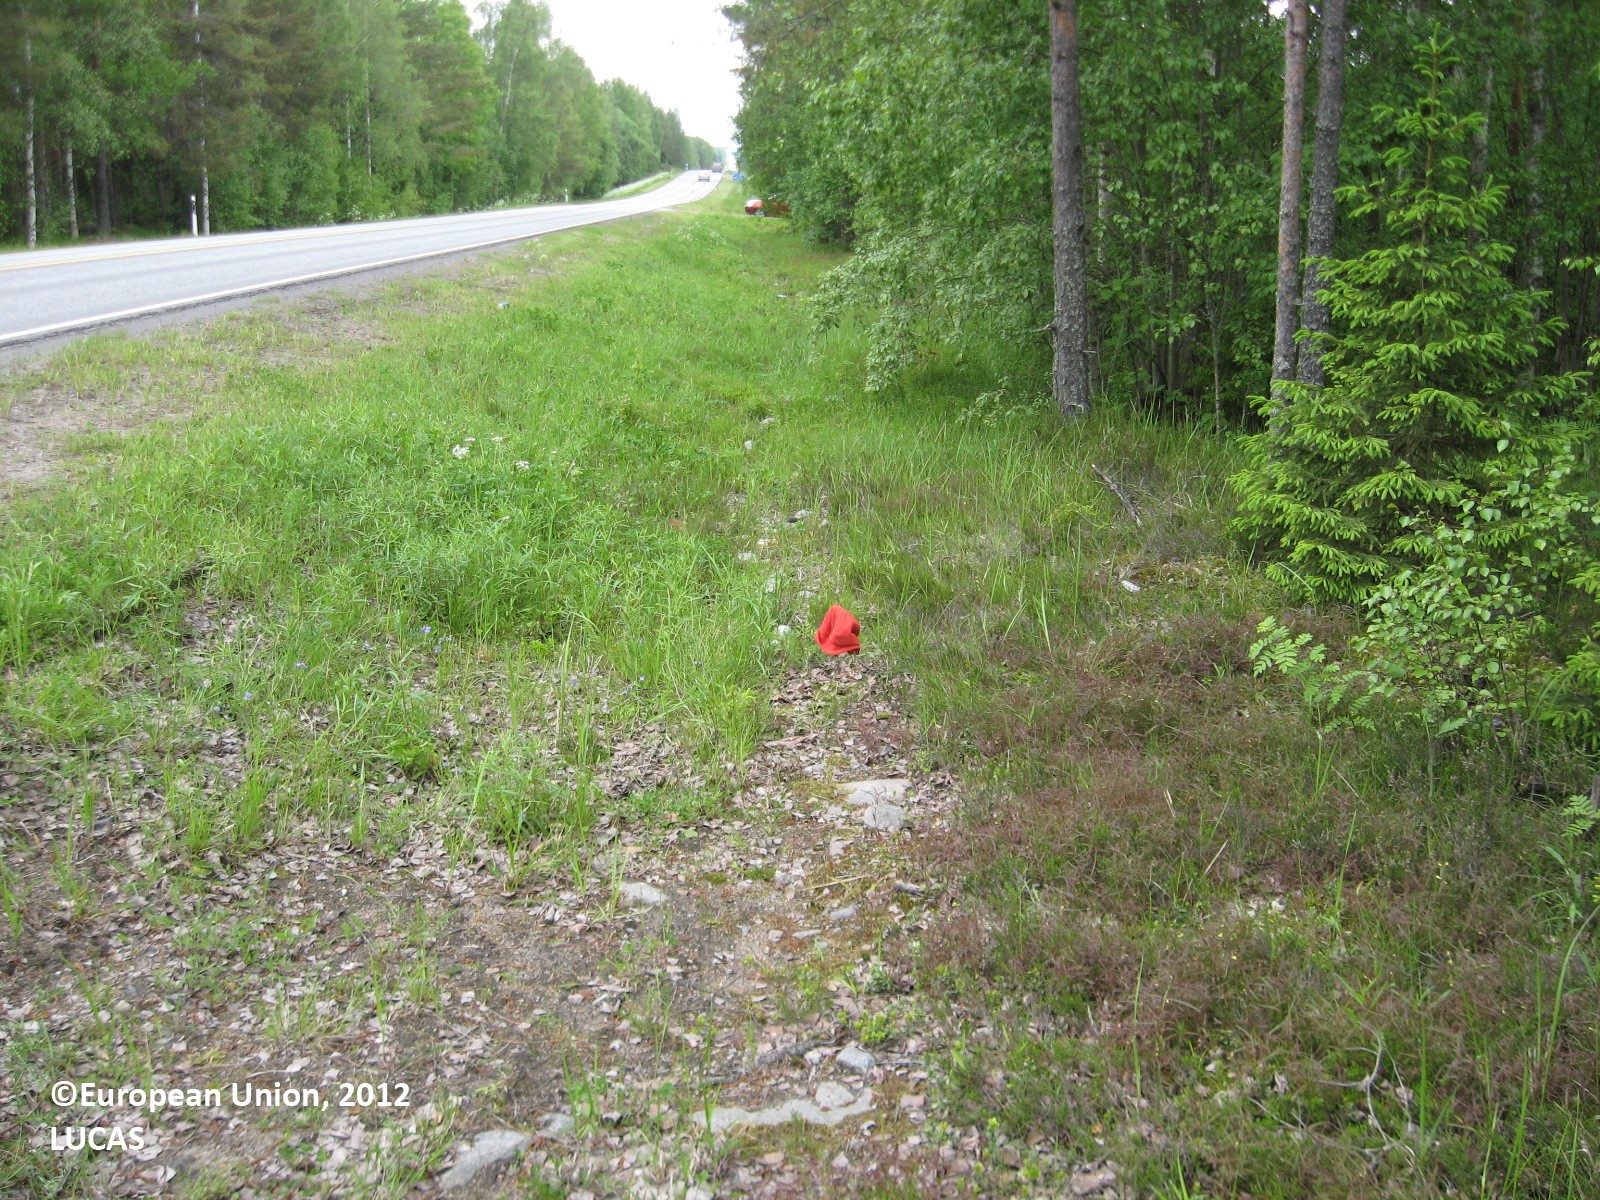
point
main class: Woodland
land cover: Spruce dominated mixed woodland
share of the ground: > 75 %
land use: Forestry
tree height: > 5 m
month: June
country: FI
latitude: 62.9826
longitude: 21.6236
